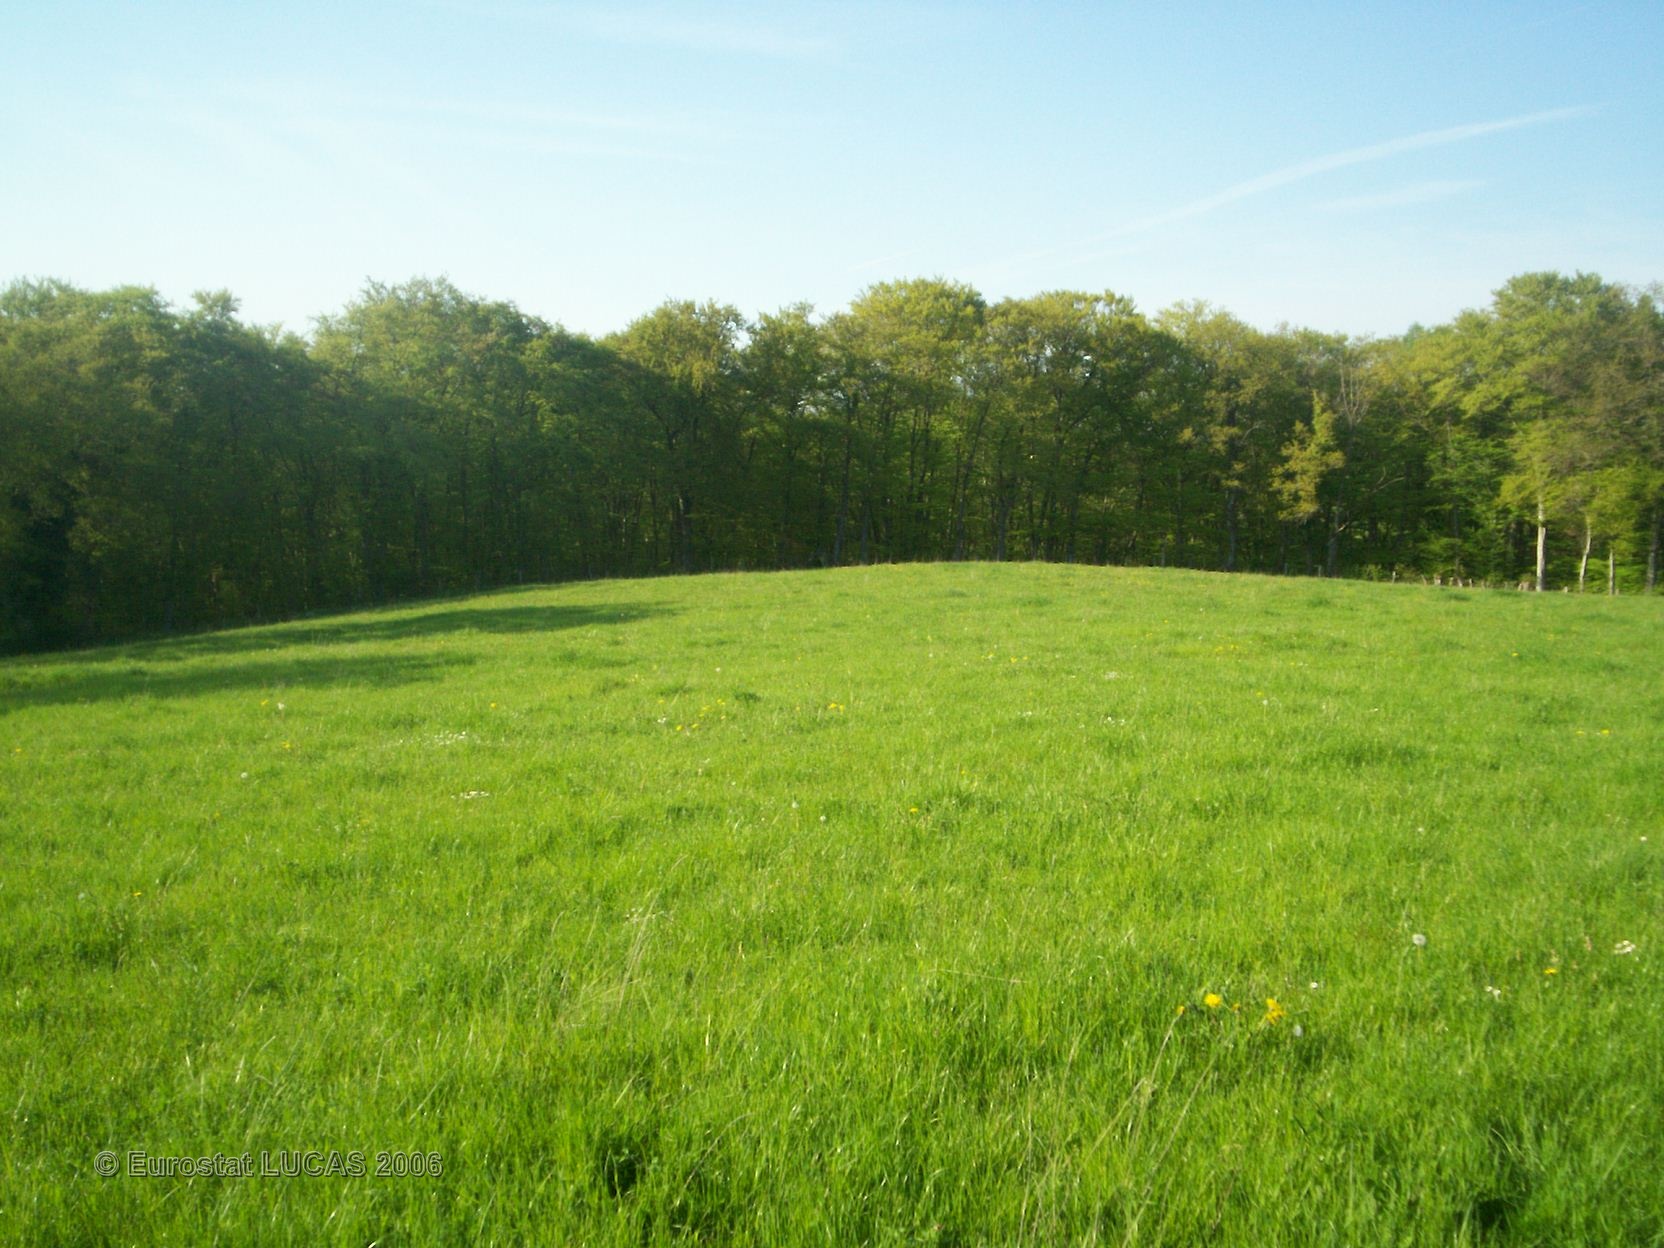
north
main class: Grassland
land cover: Grassland without tree/shrub cover
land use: Agriculture (excluding fallow land and kitchen gardens)
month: May
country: FR
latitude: 46.2291
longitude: 2.9833
